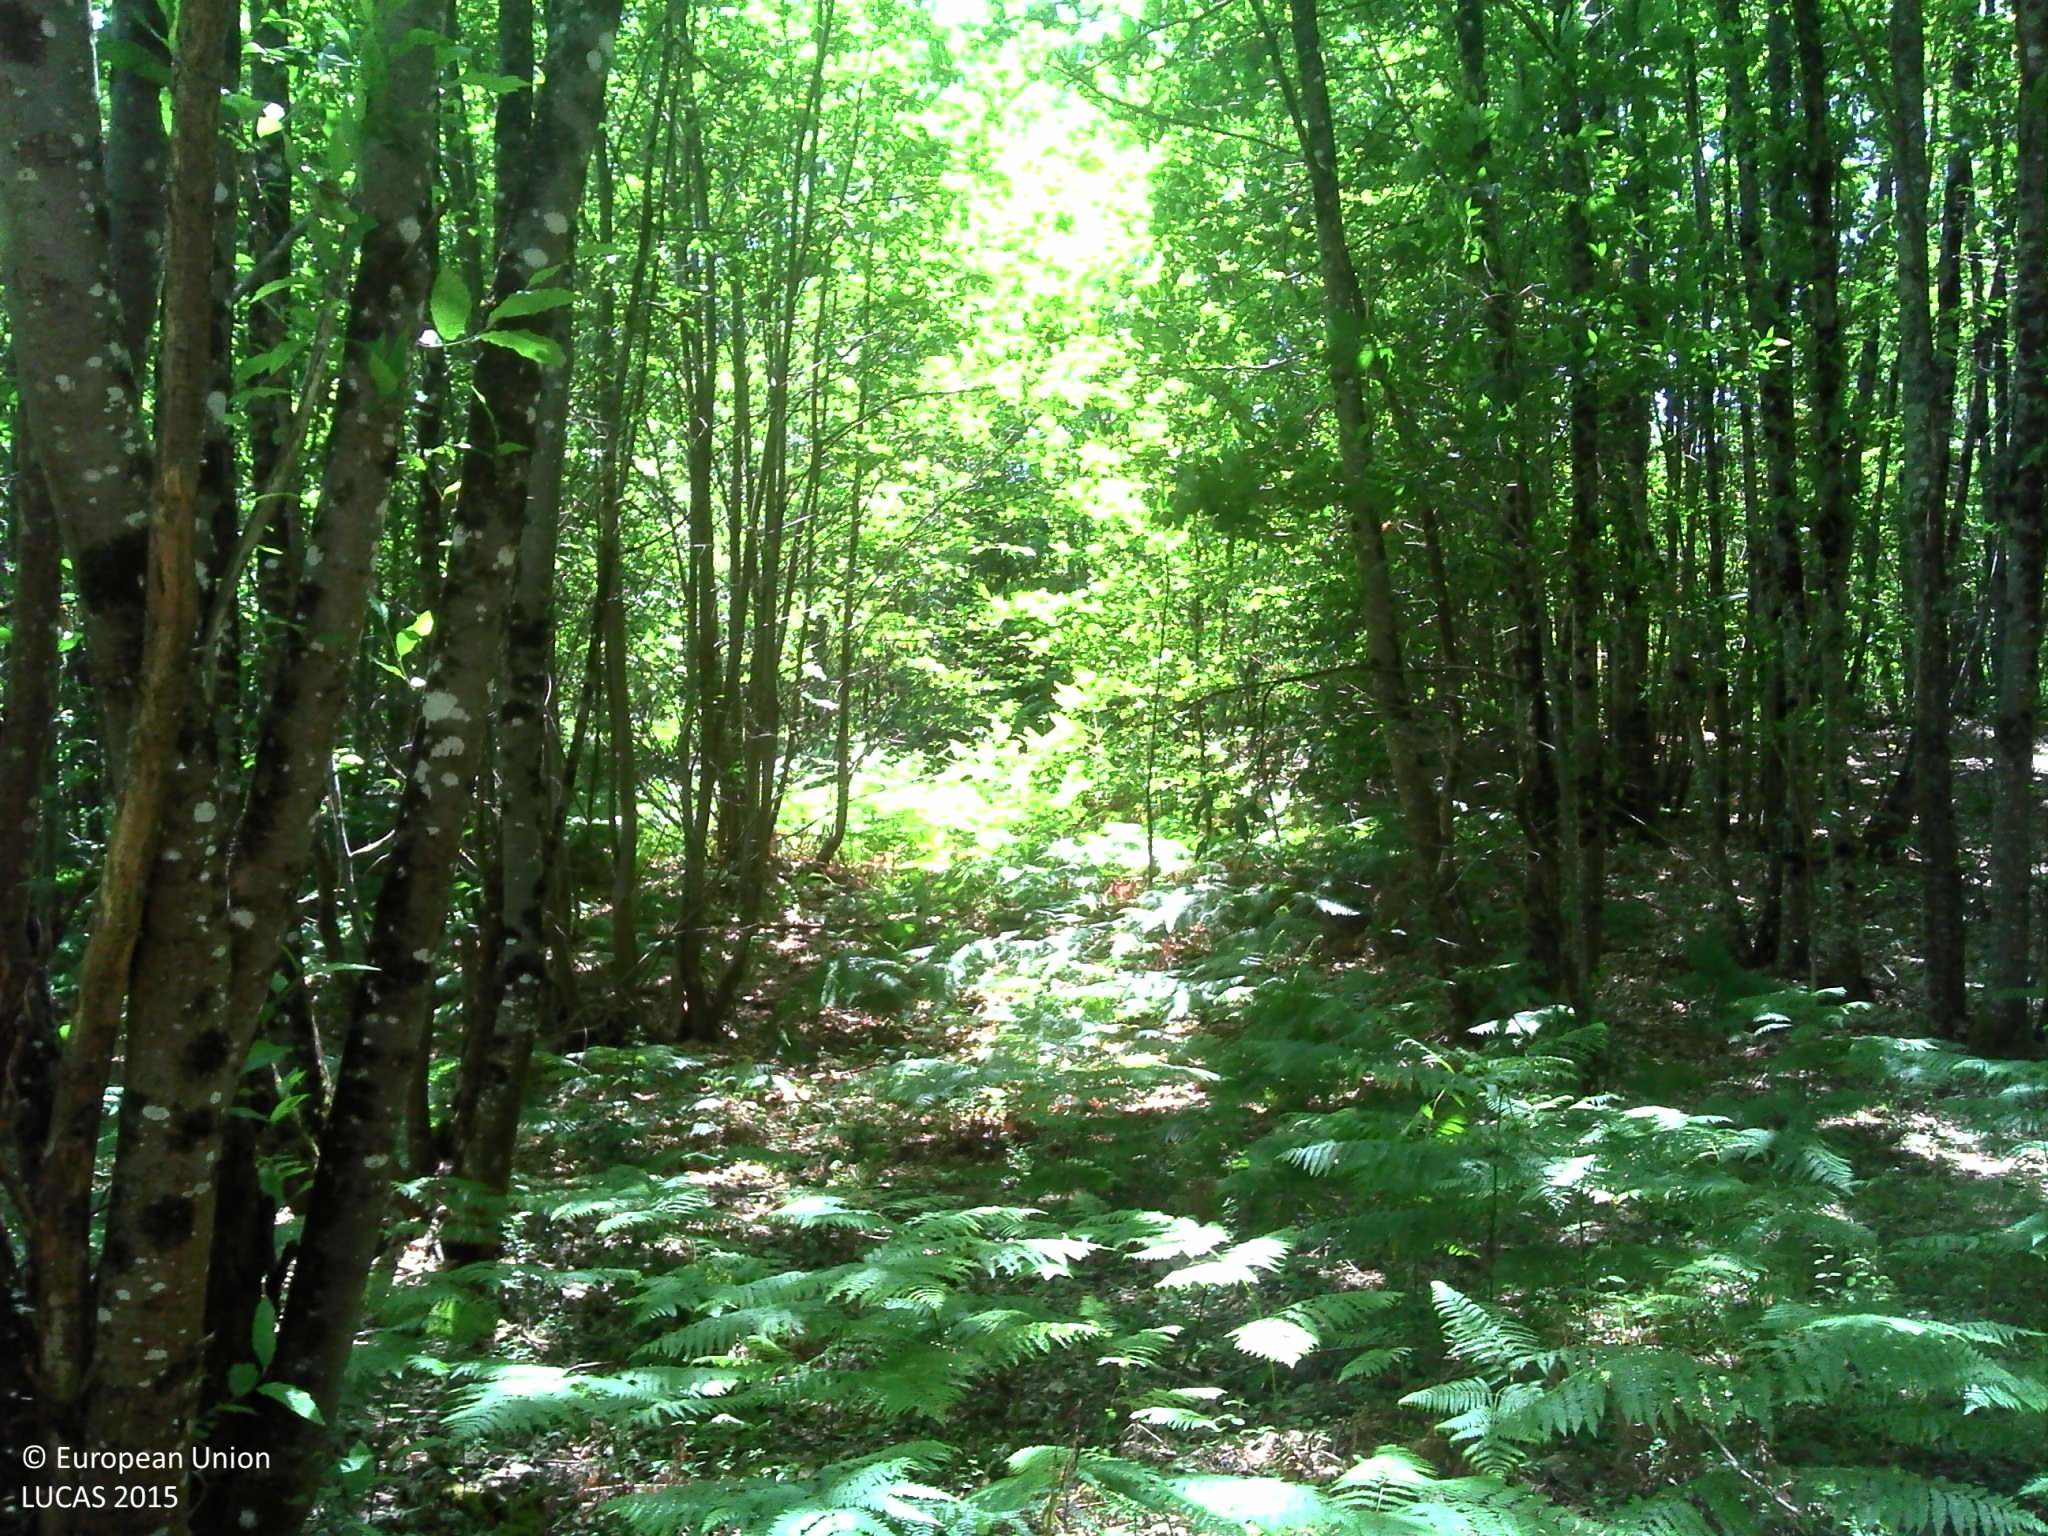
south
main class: Woodland
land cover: Broadleaved woodland
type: mesophytic deciduous forest
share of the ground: > 75 %
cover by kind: broadleaved forest trees 65 %, unconsolidated bare surface 15 %, herbaceous plants 10 %, lichens and mosses 10 %
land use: Forestry
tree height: > 5 m
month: June
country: FR
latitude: 47.3788
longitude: 0.1081
